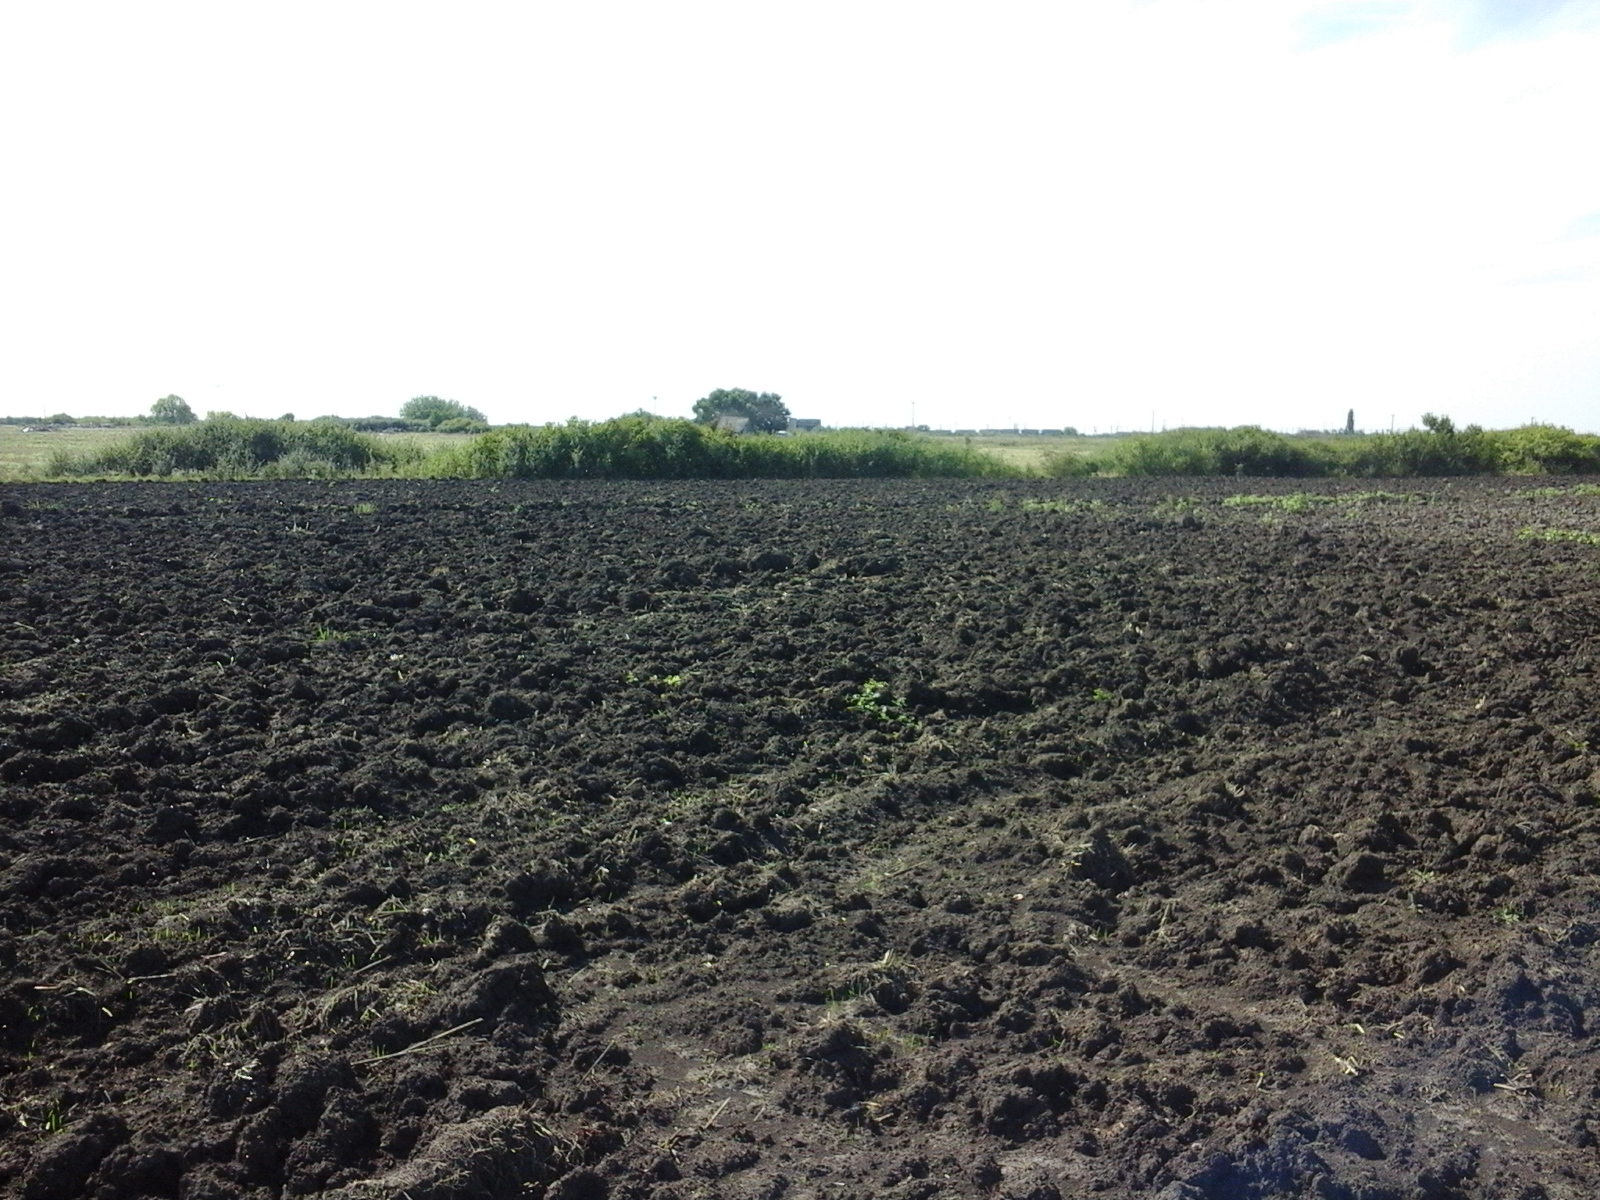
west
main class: Cropland
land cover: Oats
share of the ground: < 10 %
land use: Agriculture (excluding fallow land and kitchen gardens)
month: August
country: RO
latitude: 45.7812
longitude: 21.1814
